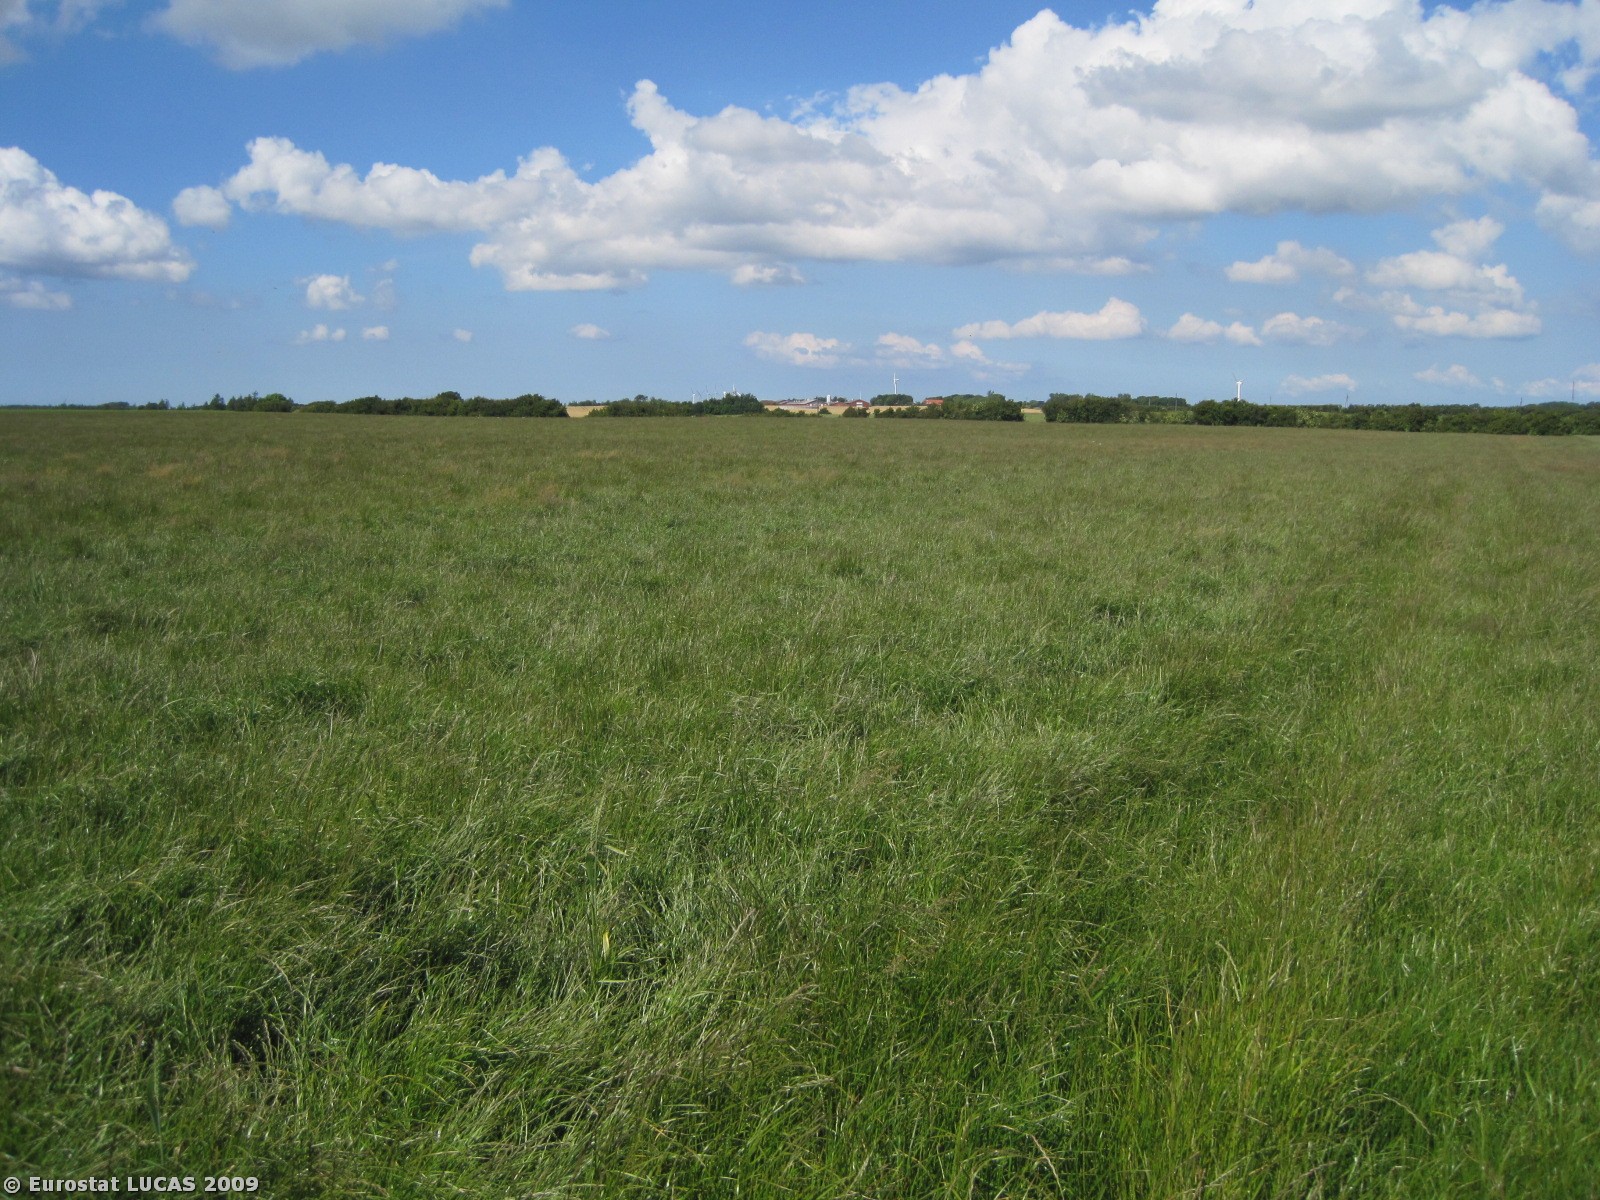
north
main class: Cropland
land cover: Temporary grasslands
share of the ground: > 75 %
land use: Agriculture (excluding fallow land and kitchen gardens)
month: June
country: DK
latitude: 56.6146
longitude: 8.9097
